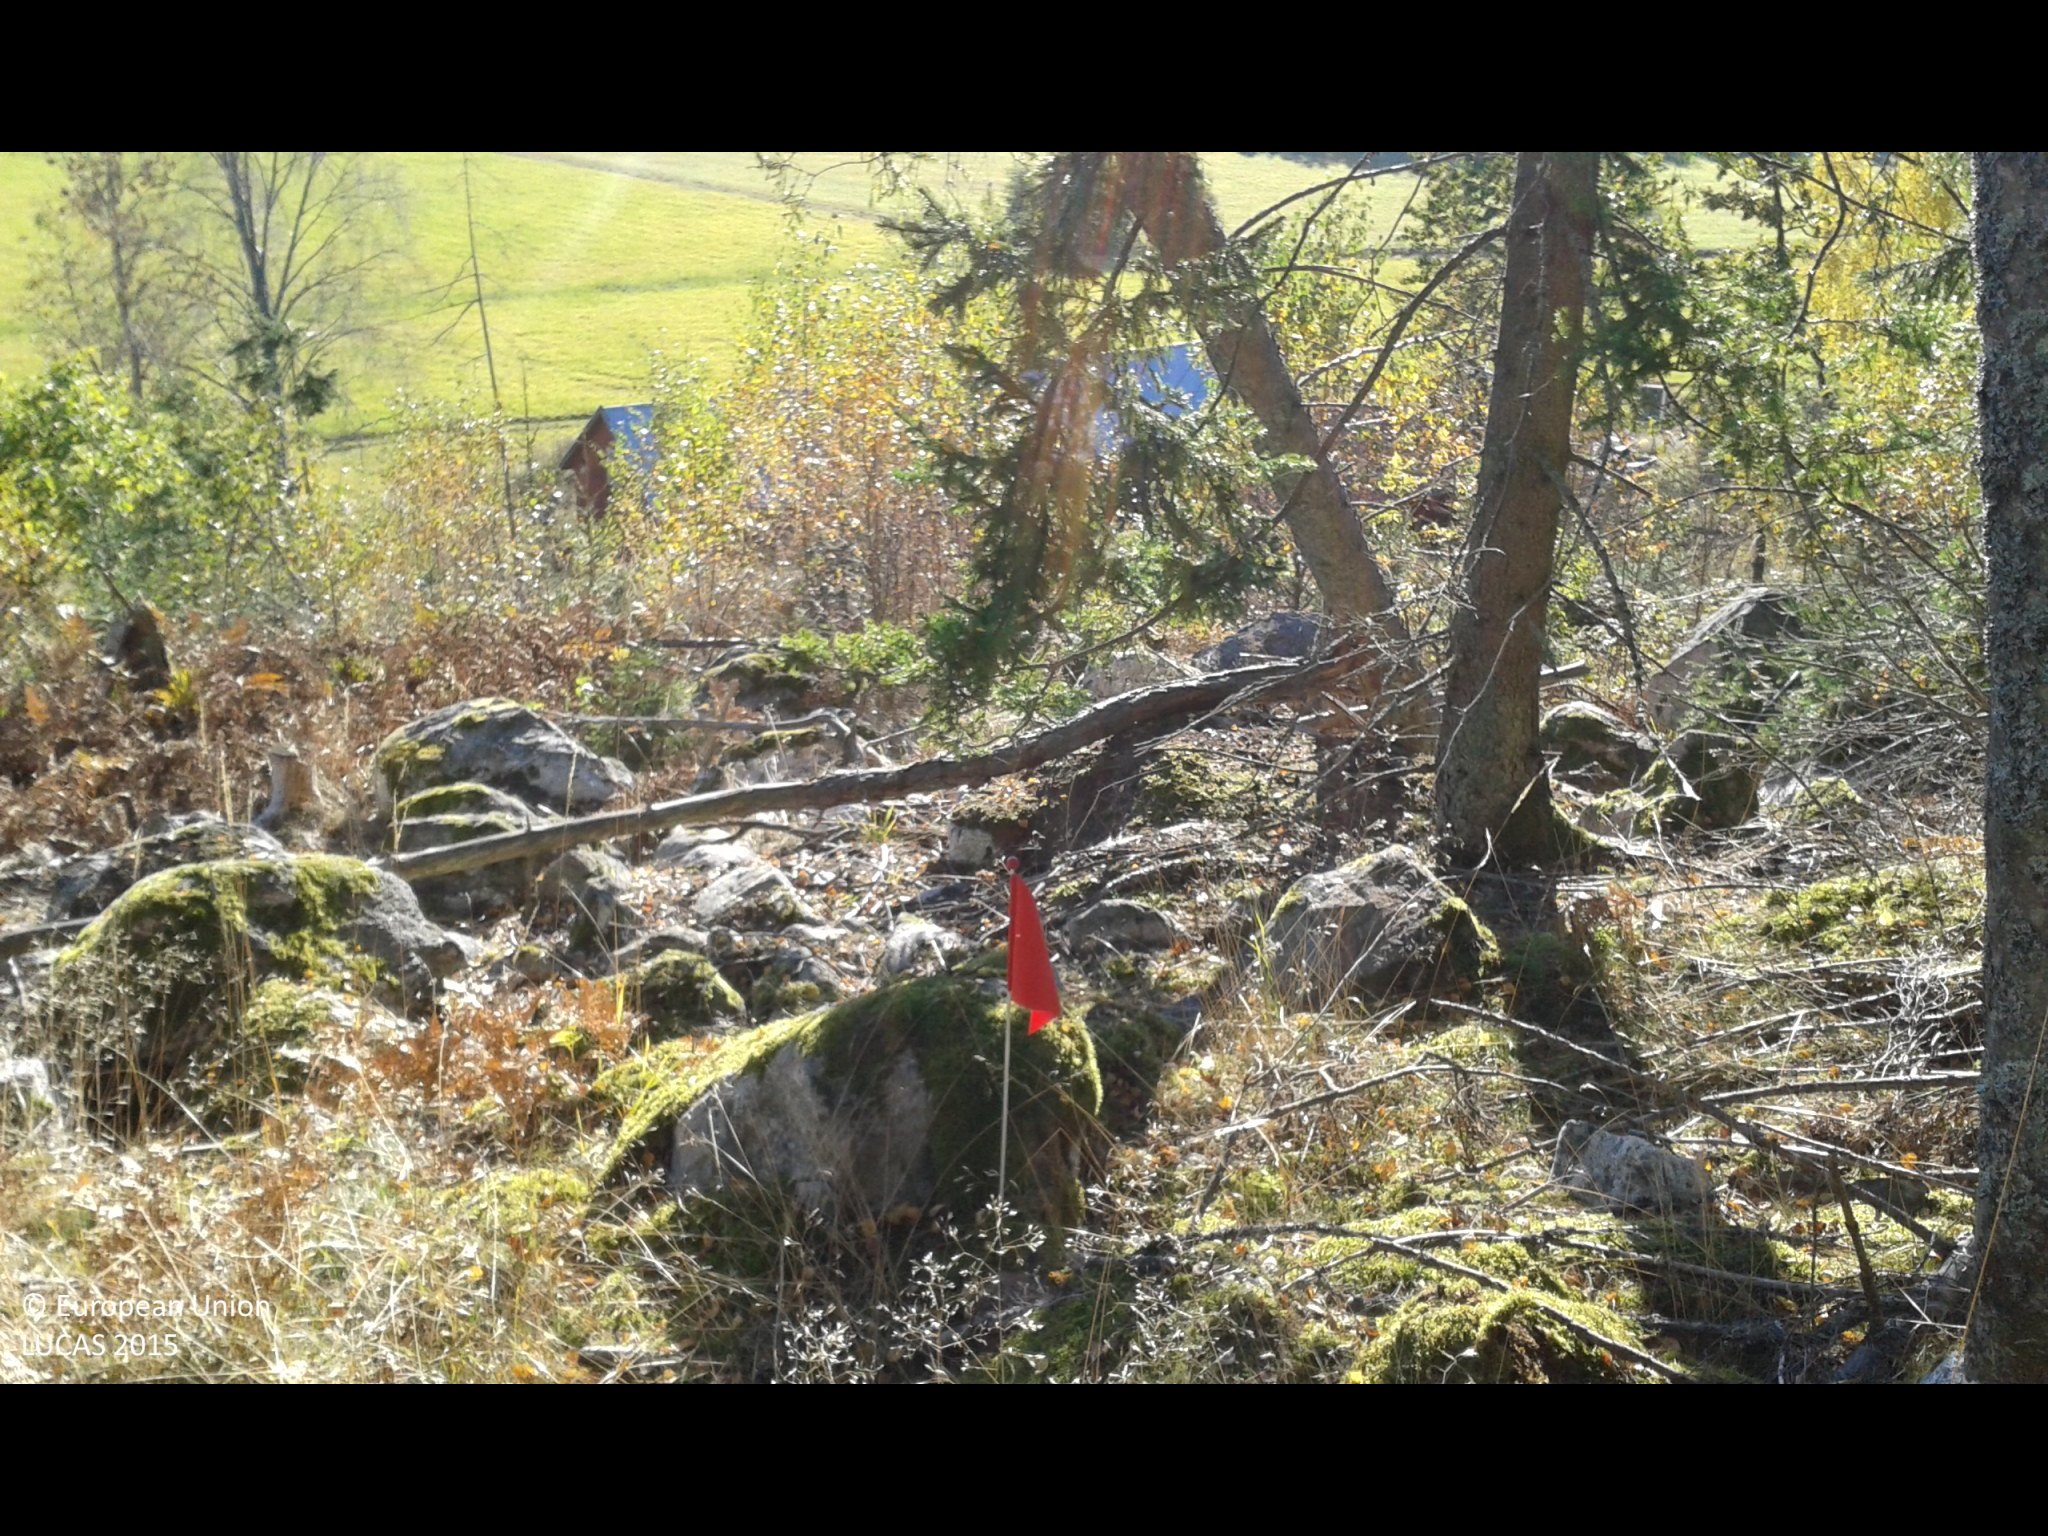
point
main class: Woodland
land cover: Spruce dominated mixed woodland
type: boreal forest
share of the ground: 25 - 50 %
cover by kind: herbaceous plants 55 %, coniferous forest trees 25 %, broadleaved forest trees 20 %
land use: Forestry
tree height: > 5 m
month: October
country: SE
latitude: 58.8329
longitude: 17.3254
